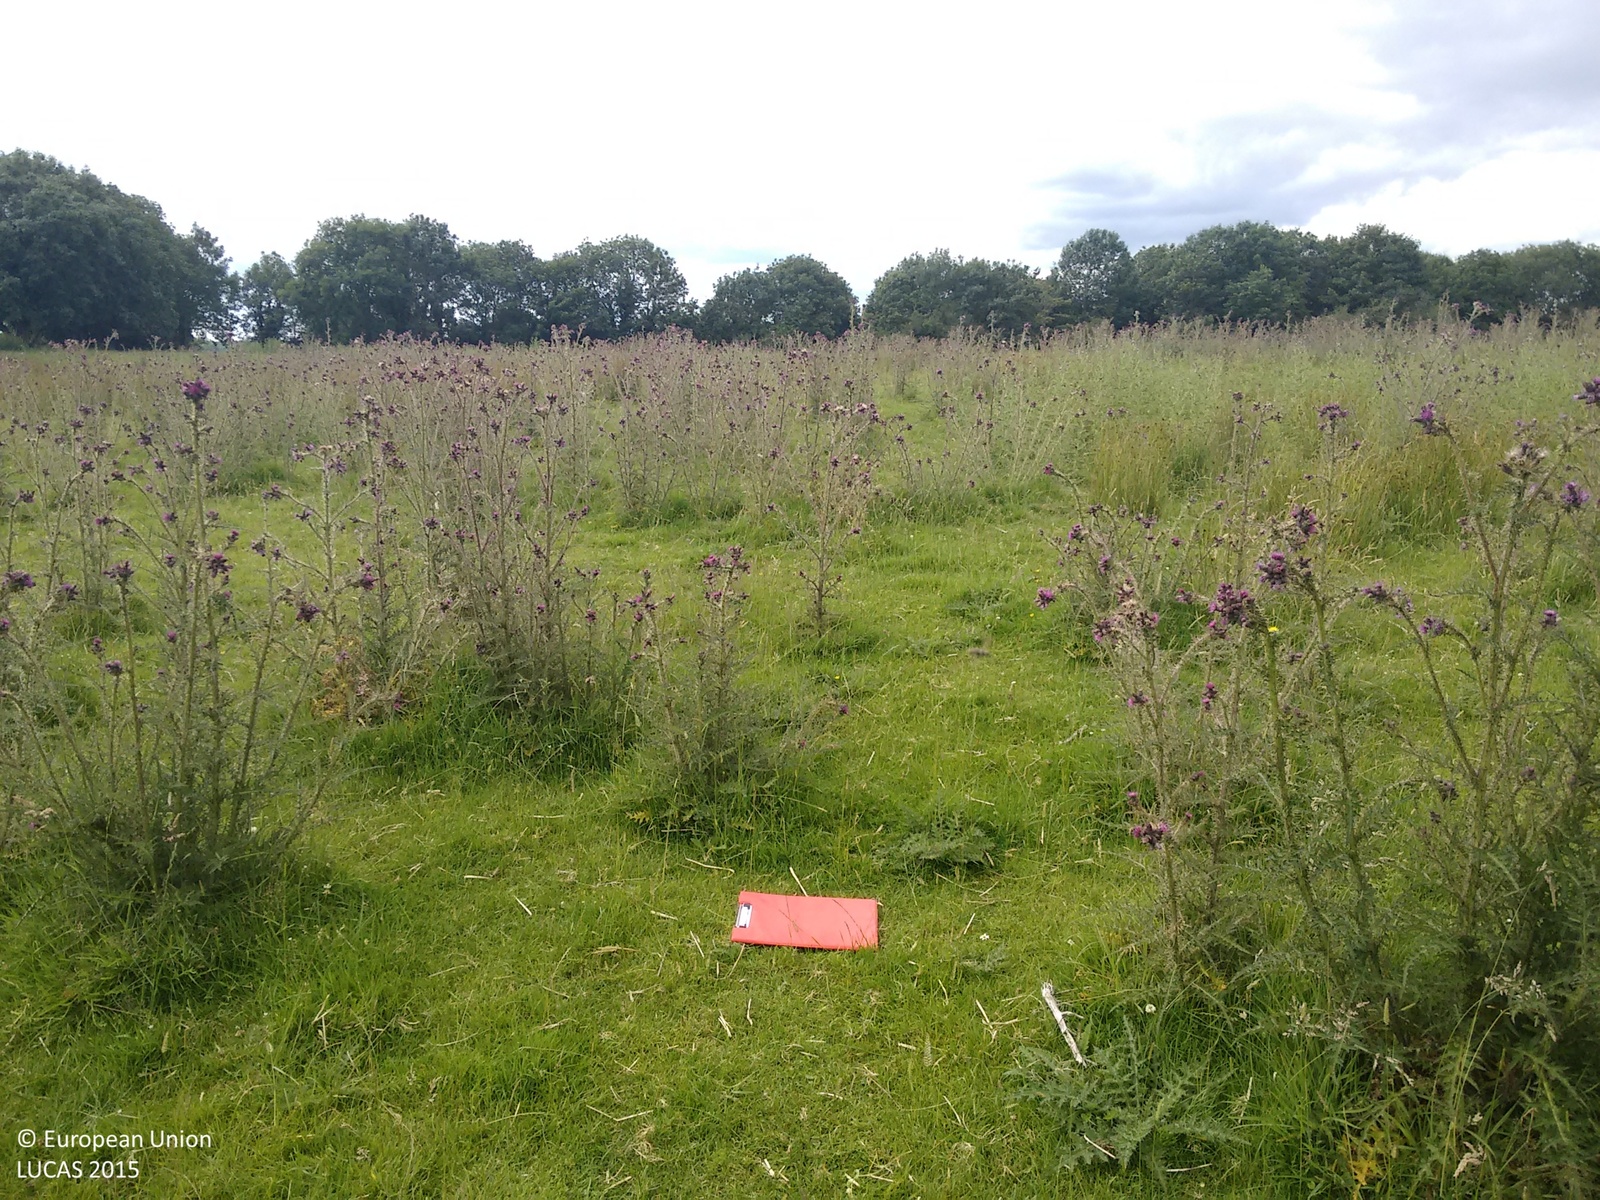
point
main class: Grassland
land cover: Grassland without tree/shrub cover
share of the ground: > 75 %
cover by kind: herbaceous plants 95 %, shrubs 5 %
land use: Agriculture (excluding fallow land and kitchen gardens)
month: July
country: IE
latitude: 53.5544
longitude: -7.8456
